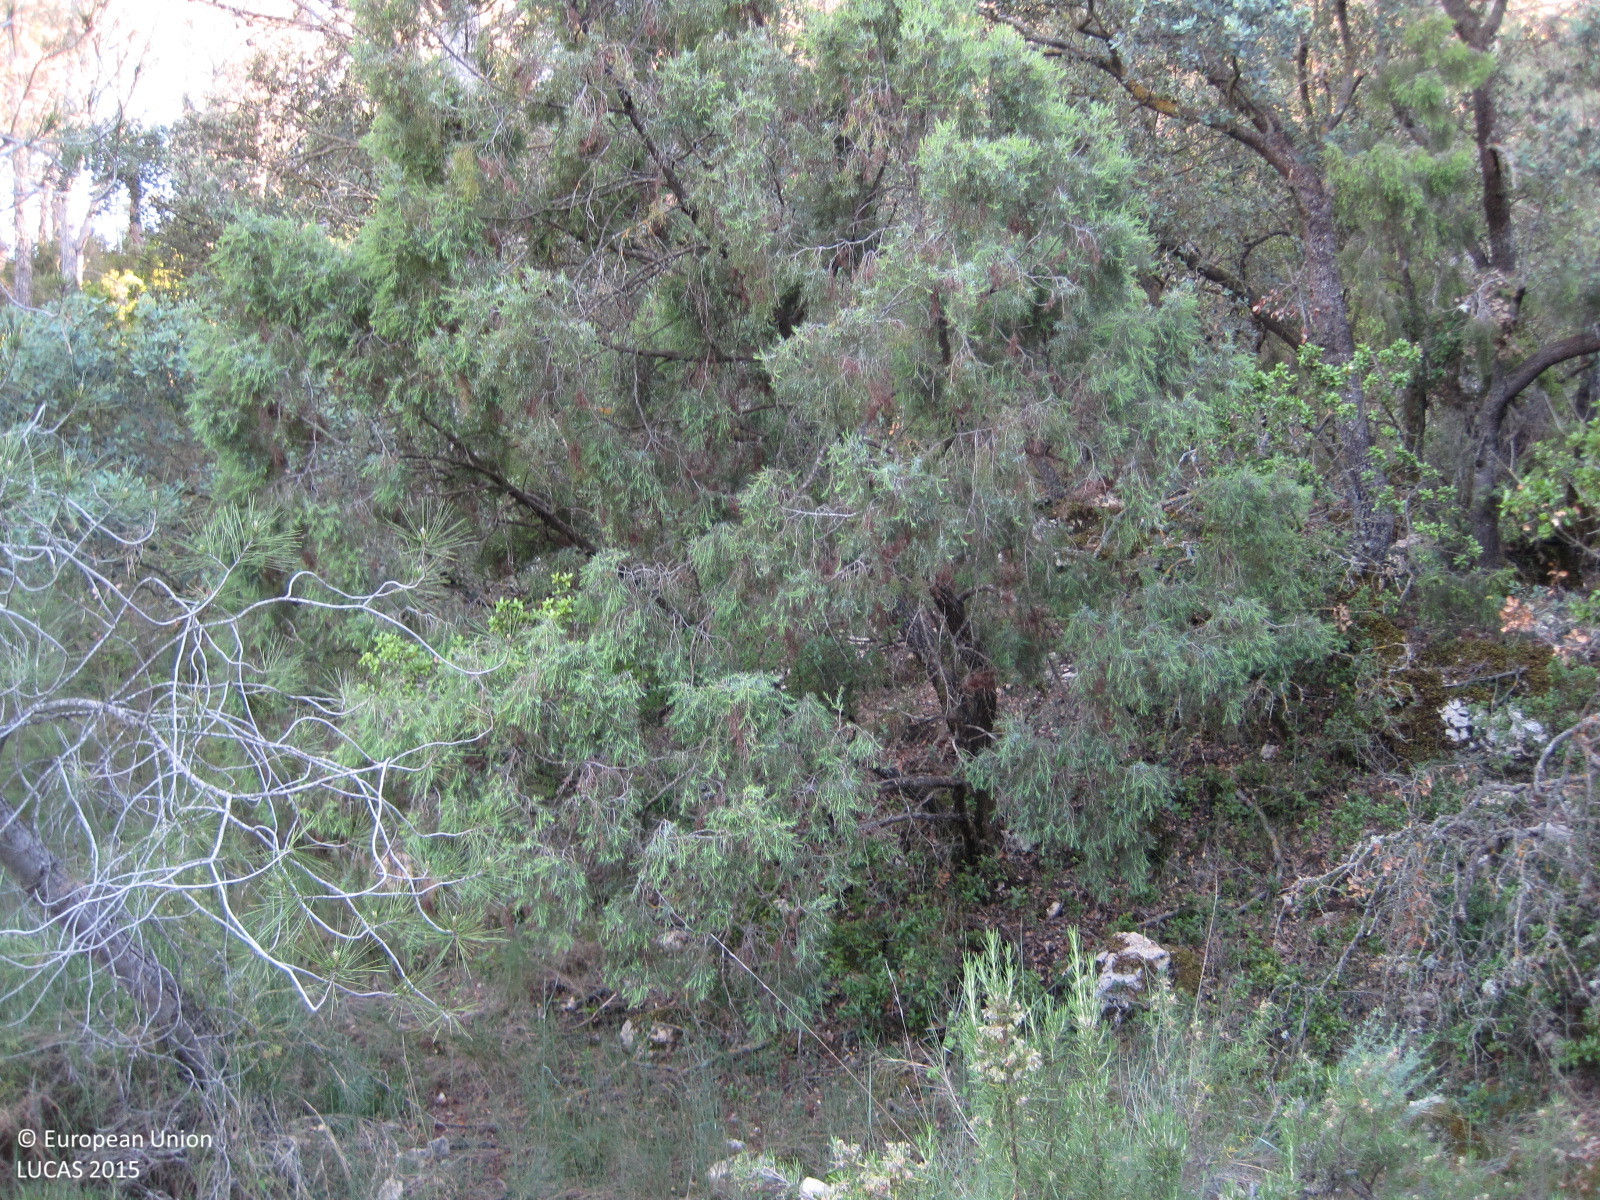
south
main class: Woodland
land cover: Broadleaved woodland
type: broadleaved evergreen forest
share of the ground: 50 - 75 %
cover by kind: broadleaved forest trees 50 %, shrubs 25 %, coniferous forest trees 15 %, herbaceous plants 10 %
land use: Forestry
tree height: > 5 m
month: May
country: ES
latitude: 39.4378
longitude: -1.0731
